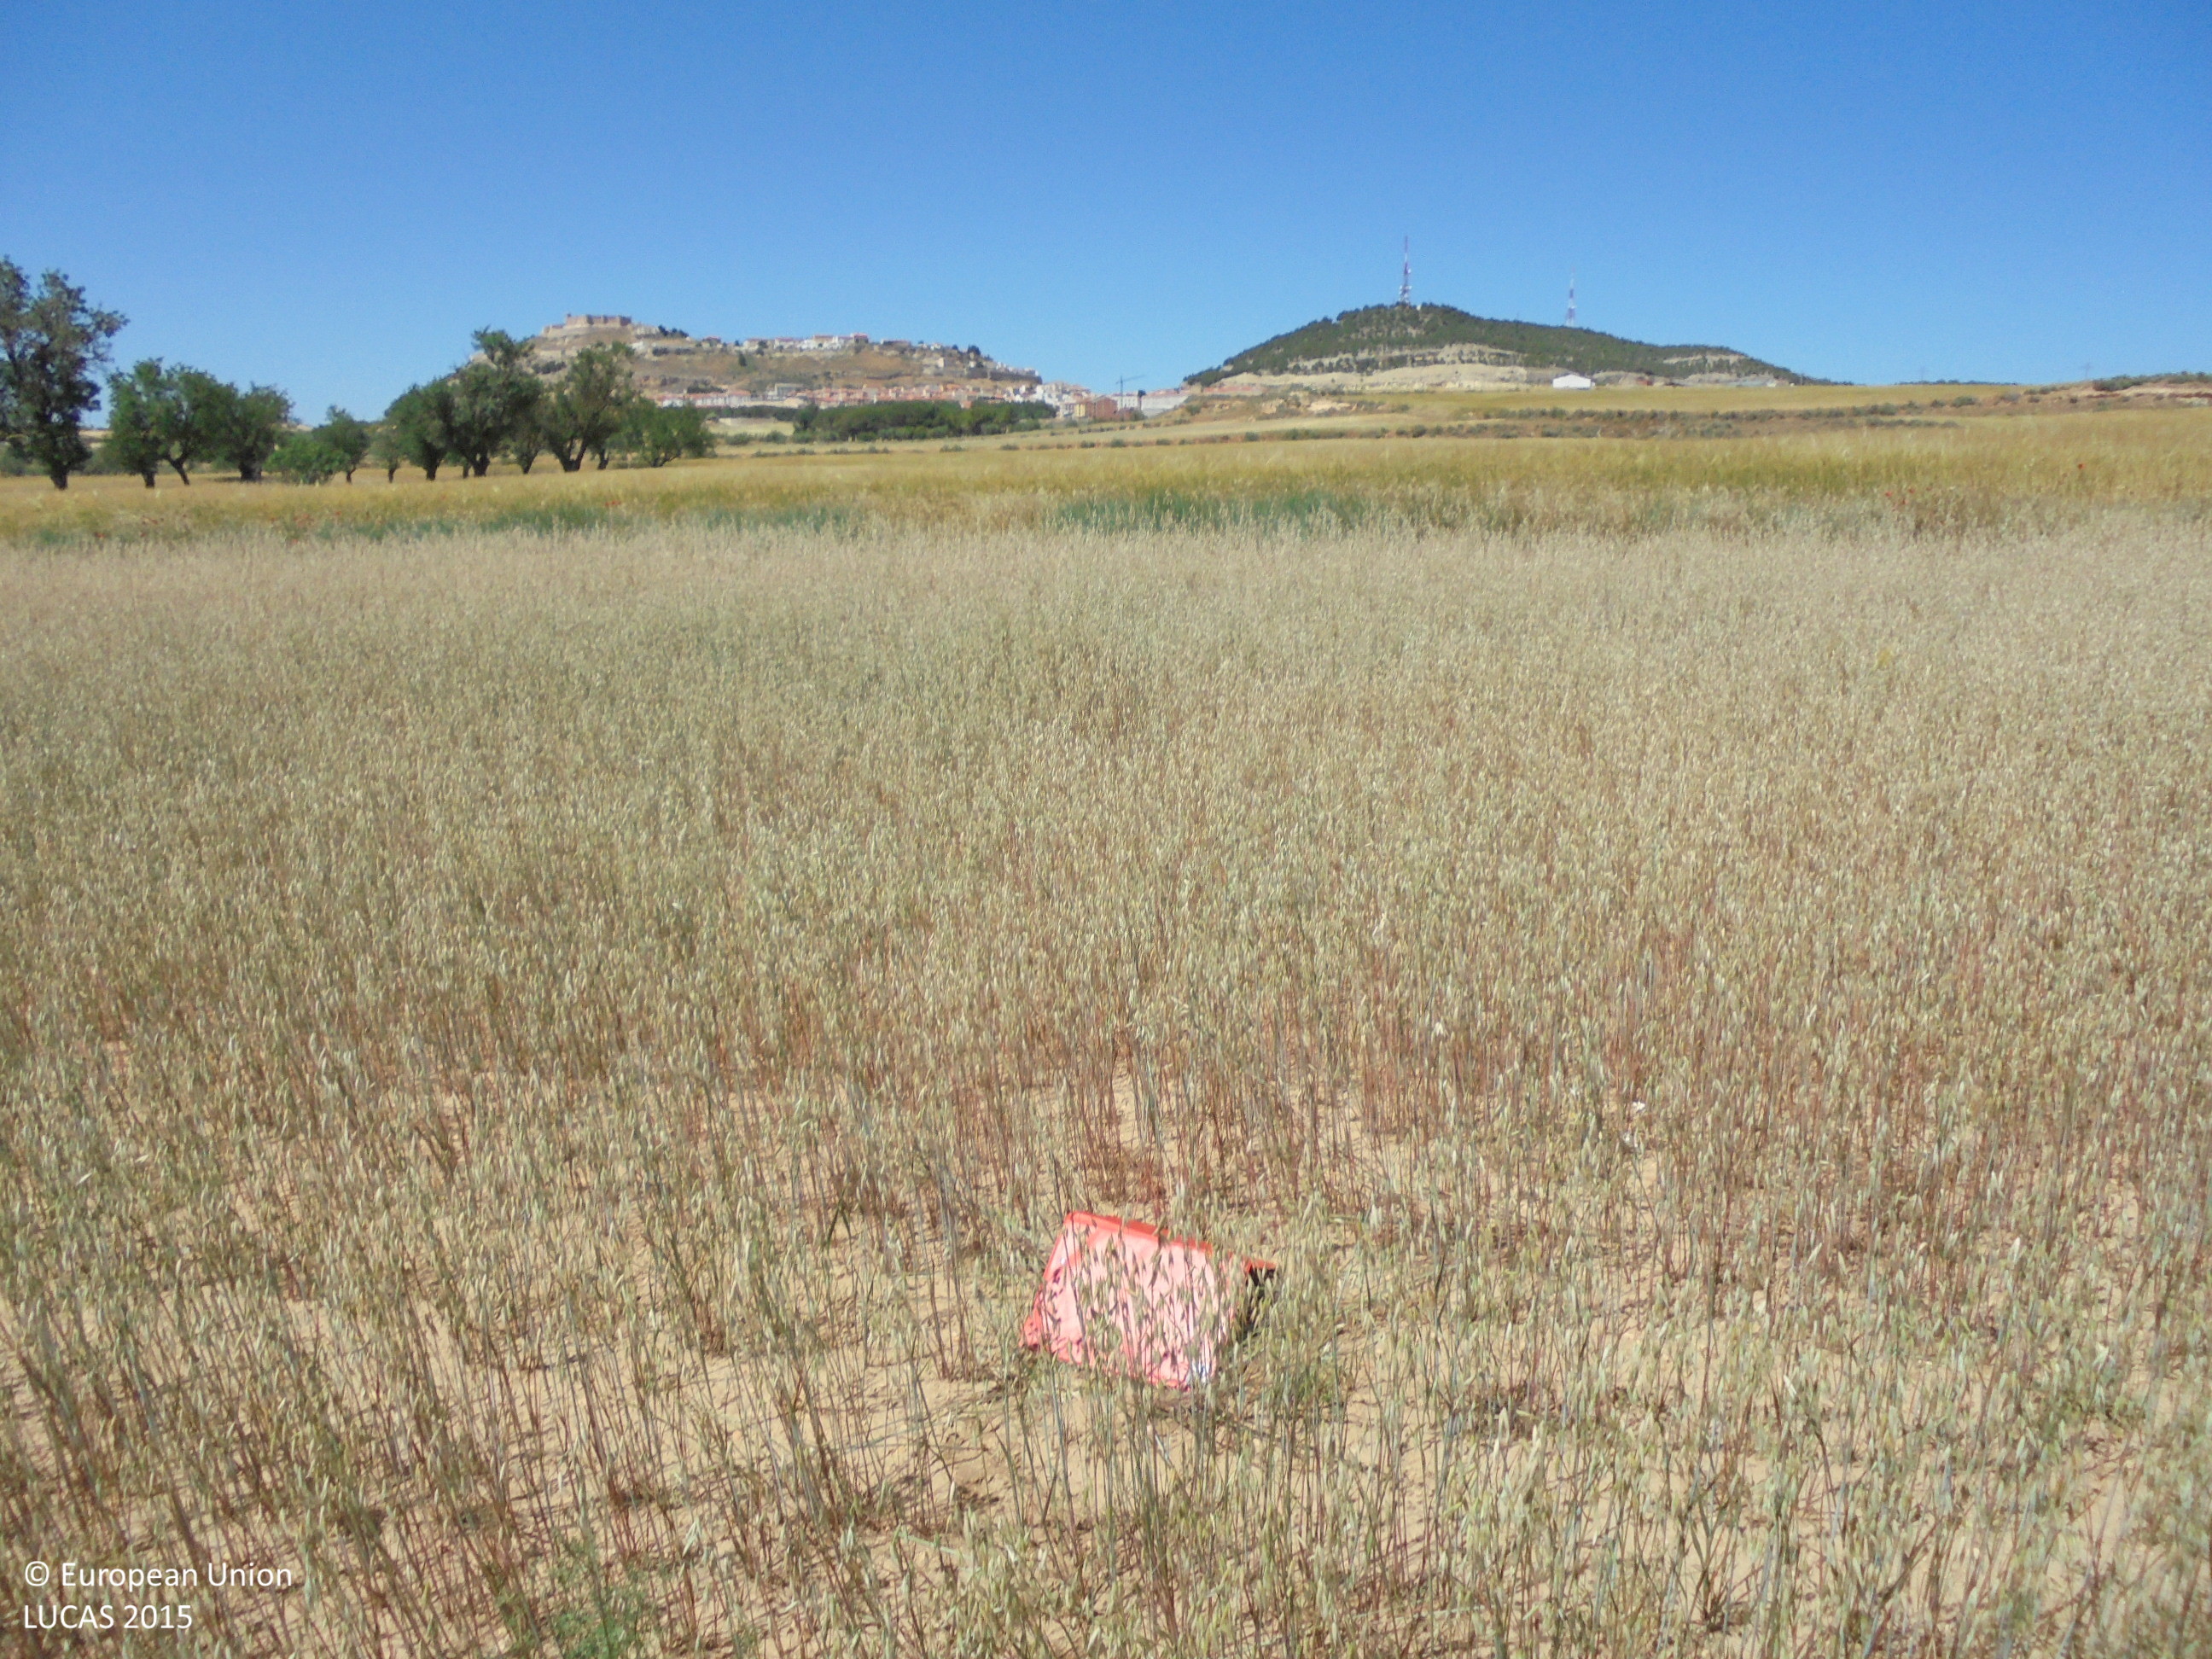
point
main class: Cropland
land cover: Oats
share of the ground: 25 - 50 %
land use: Agriculture (excluding fallow land and kitchen gardens)
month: May
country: ES
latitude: 38.9038
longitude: -1.7255
